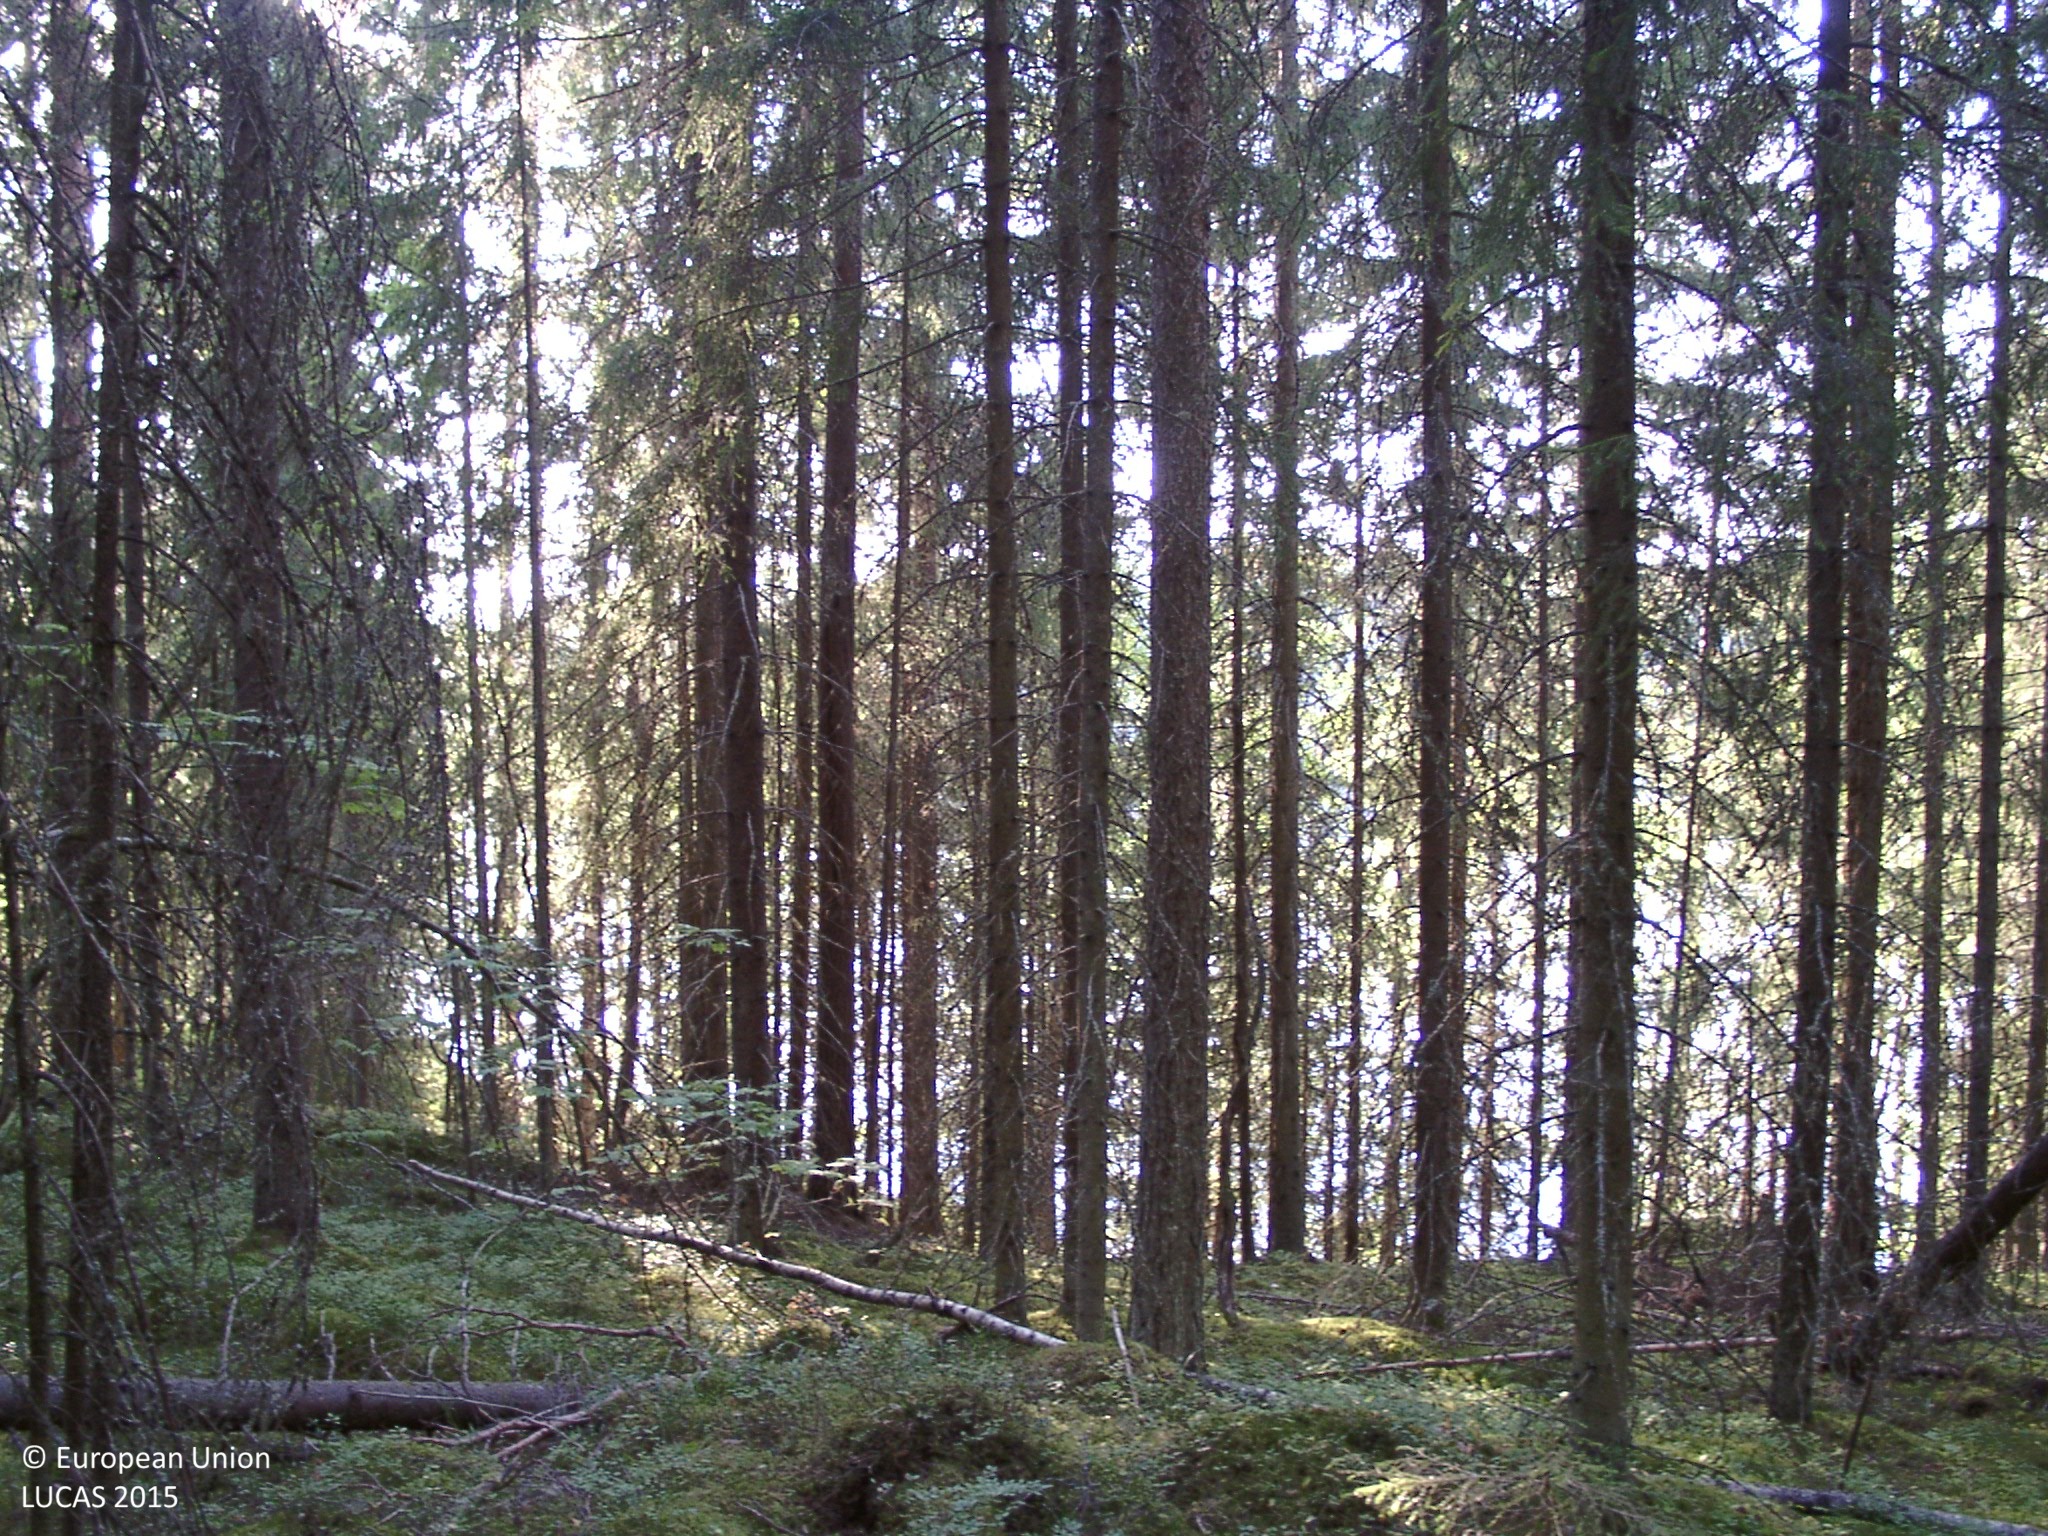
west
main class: Woodland
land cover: Spruce dominated coniferous woodland
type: boreal forest
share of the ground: > 75 %
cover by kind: coniferous forest trees 75 %, lichens and mosses 15 %, broadleaved forest trees 5 %, shrubs 5 %
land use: Forestry
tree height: > 5 m
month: August
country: FI
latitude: 61.7295
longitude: 24.9637
